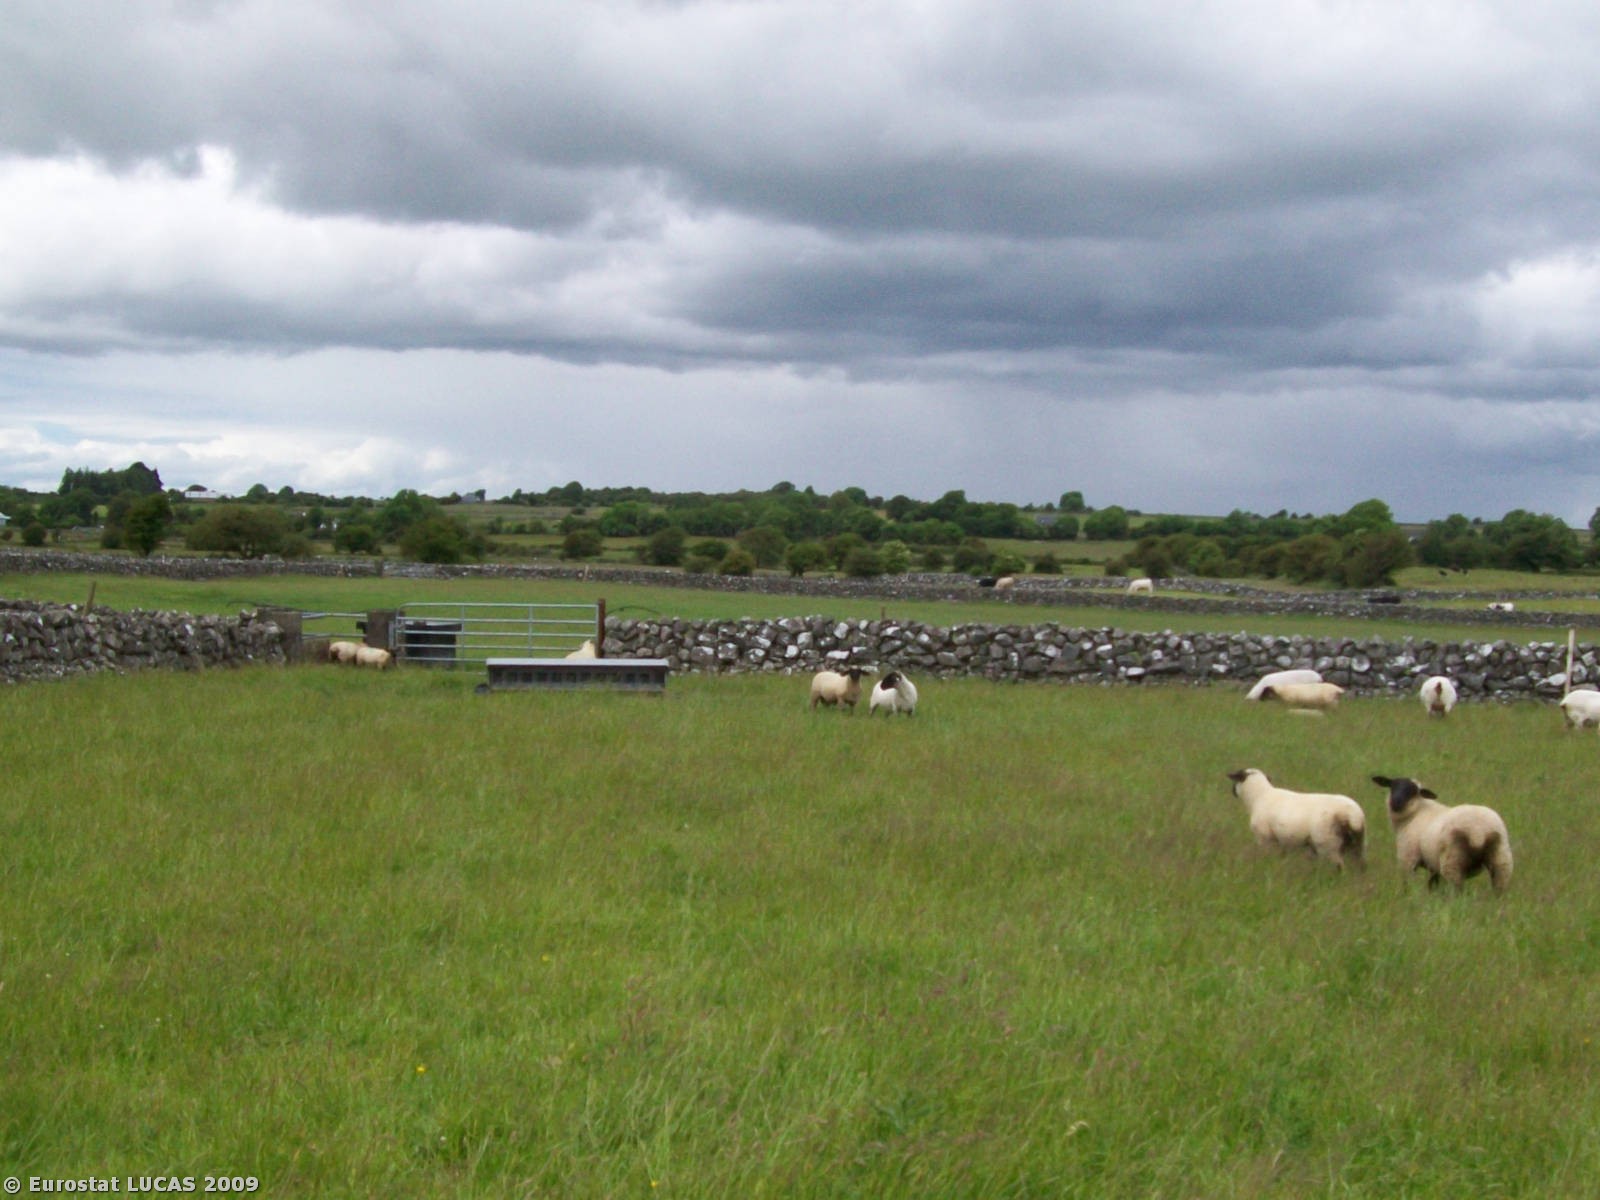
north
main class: Grassland
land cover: Grassland without tree/shrub cover
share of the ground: > 75 %
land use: Agriculture (excluding fallow land and kitchen gardens)
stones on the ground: < 10 %
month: June
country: IE
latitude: 53.3366
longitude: -8.7810
